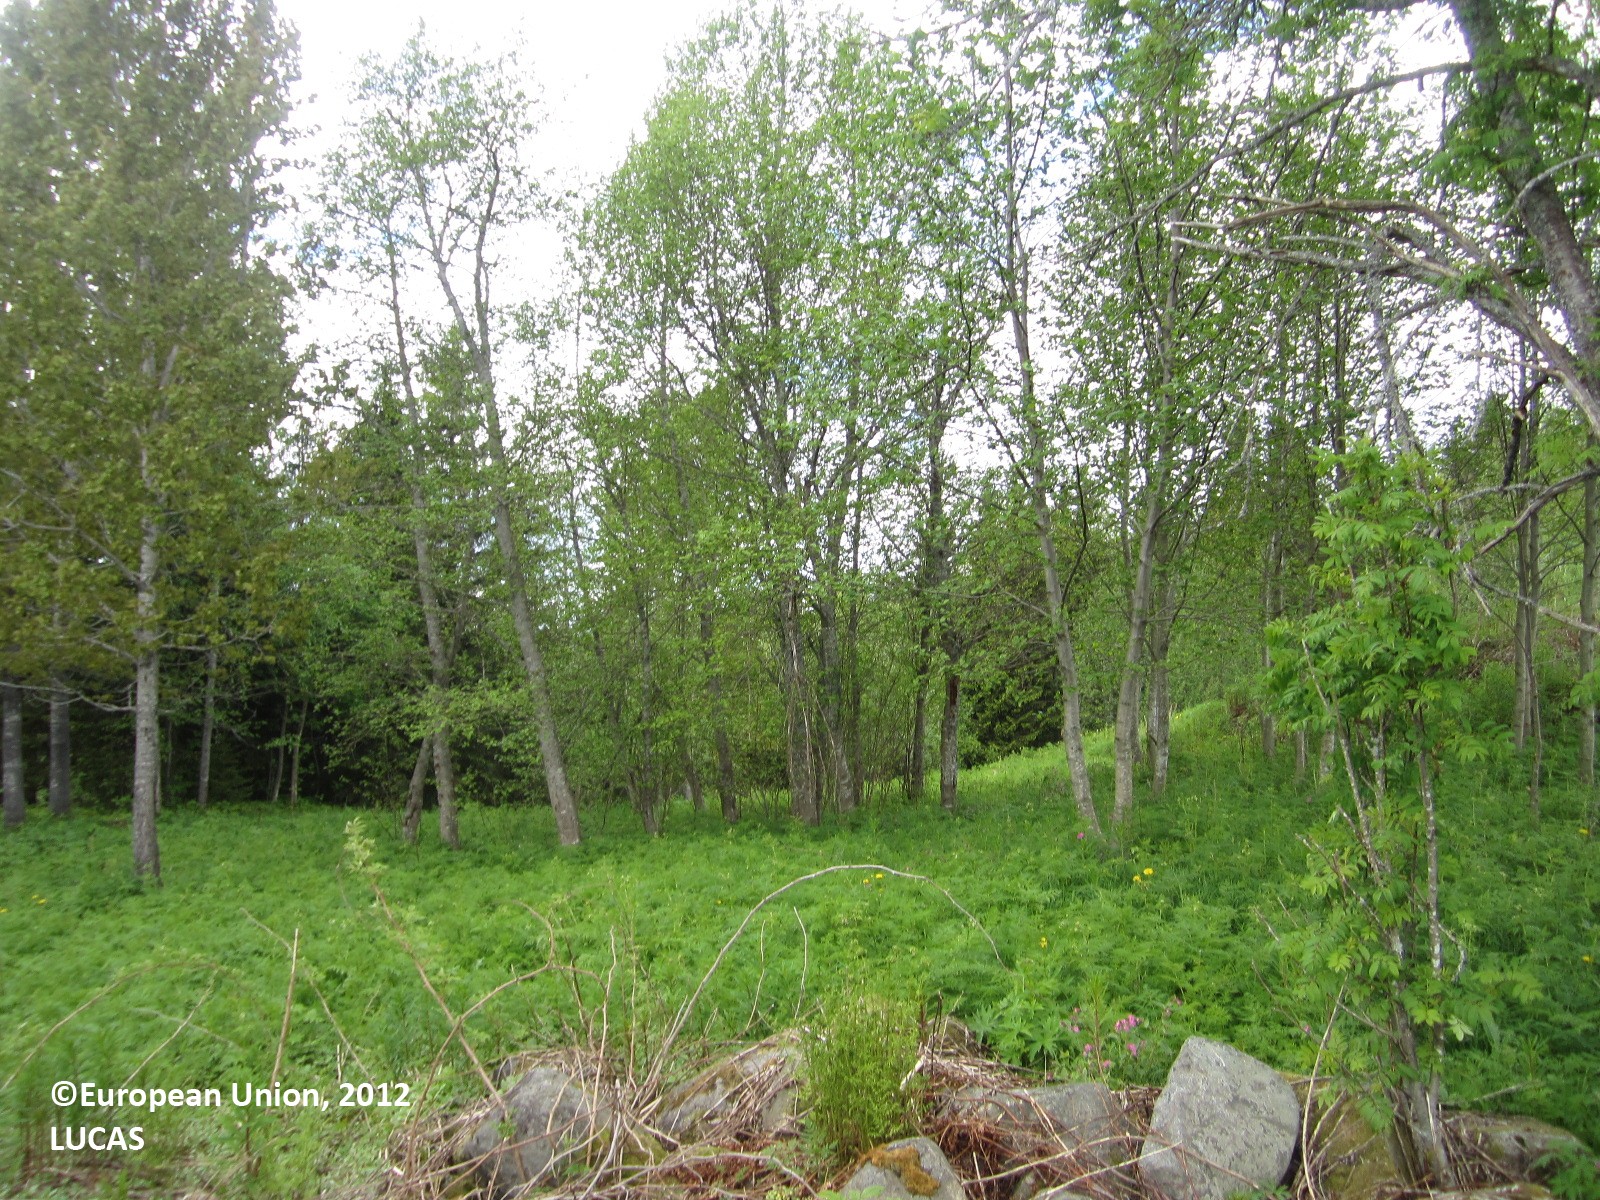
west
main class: Woodland
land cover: Broadleaved woodland
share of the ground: 10 - 25 %
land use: Forestry
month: June
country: FI
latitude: 64.5212
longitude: 28.7050
